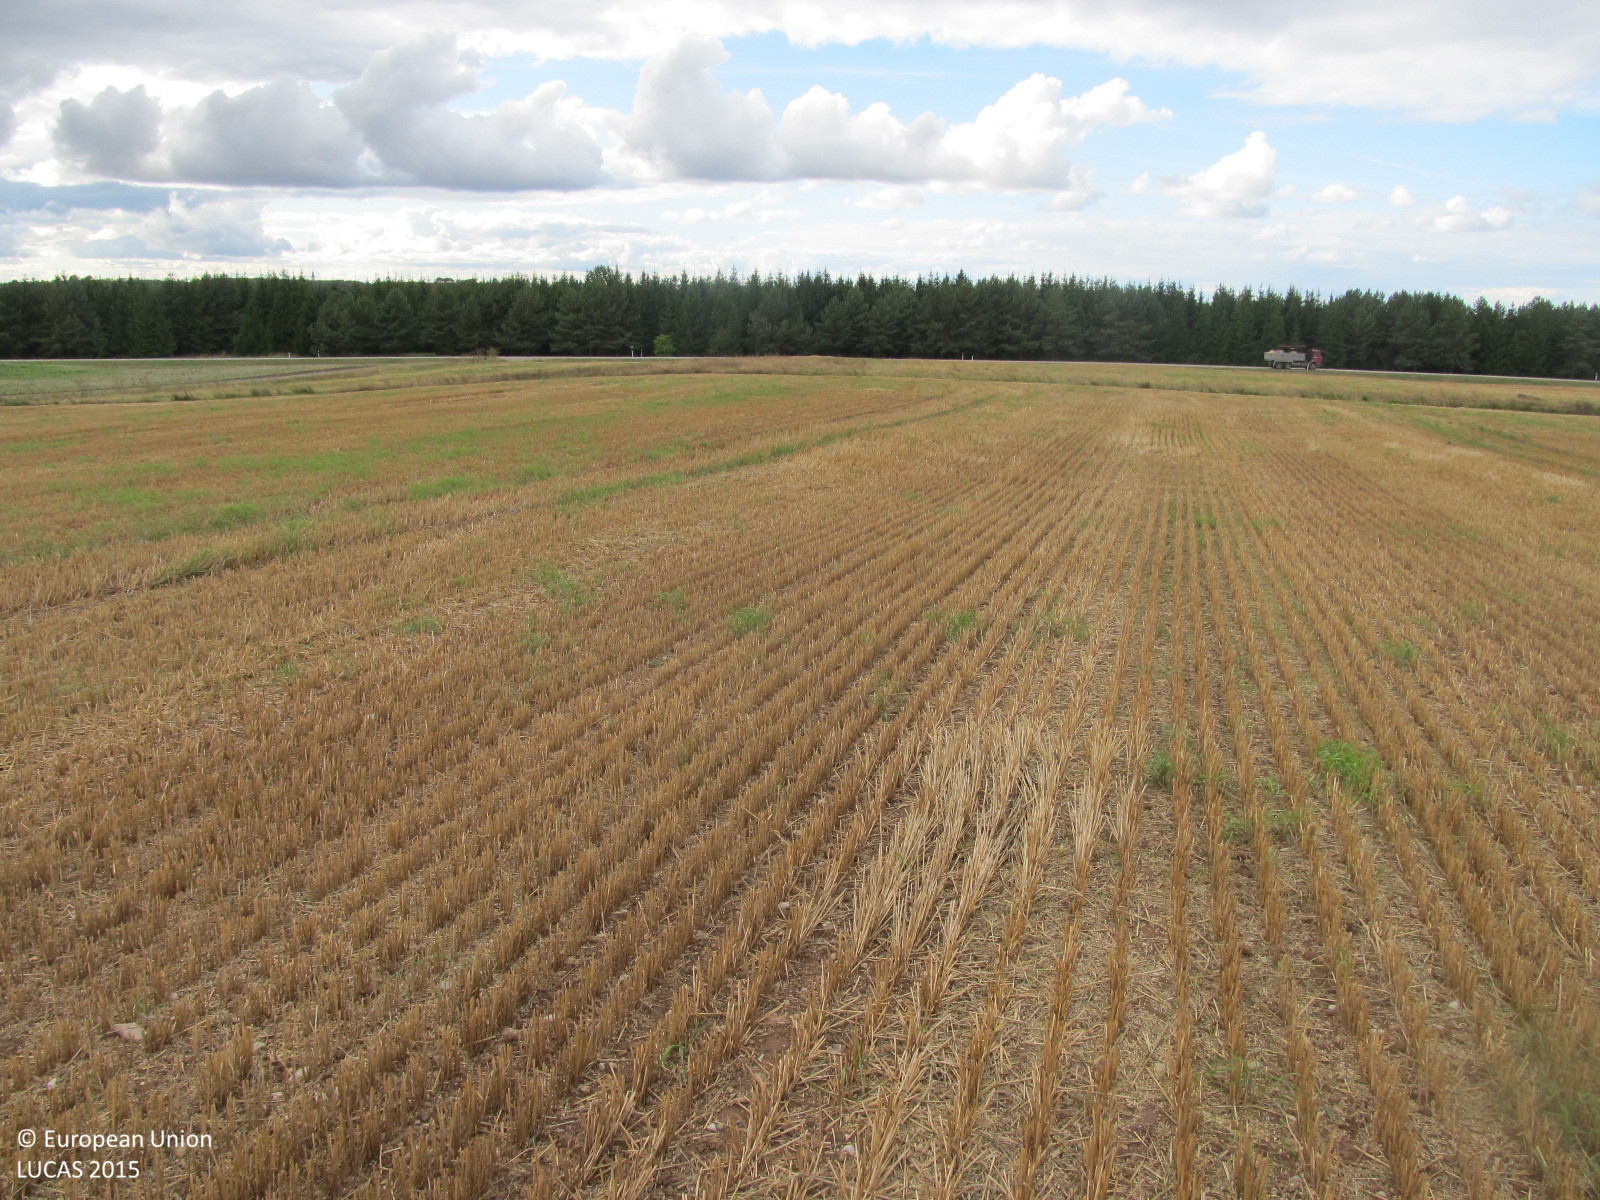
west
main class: Cropland
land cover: Common wheat
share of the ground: 50 - 75 %
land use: Agriculture (excluding fallow land and kitchen gardens)
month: September
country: LT
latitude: 55.9393
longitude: 23.3791
